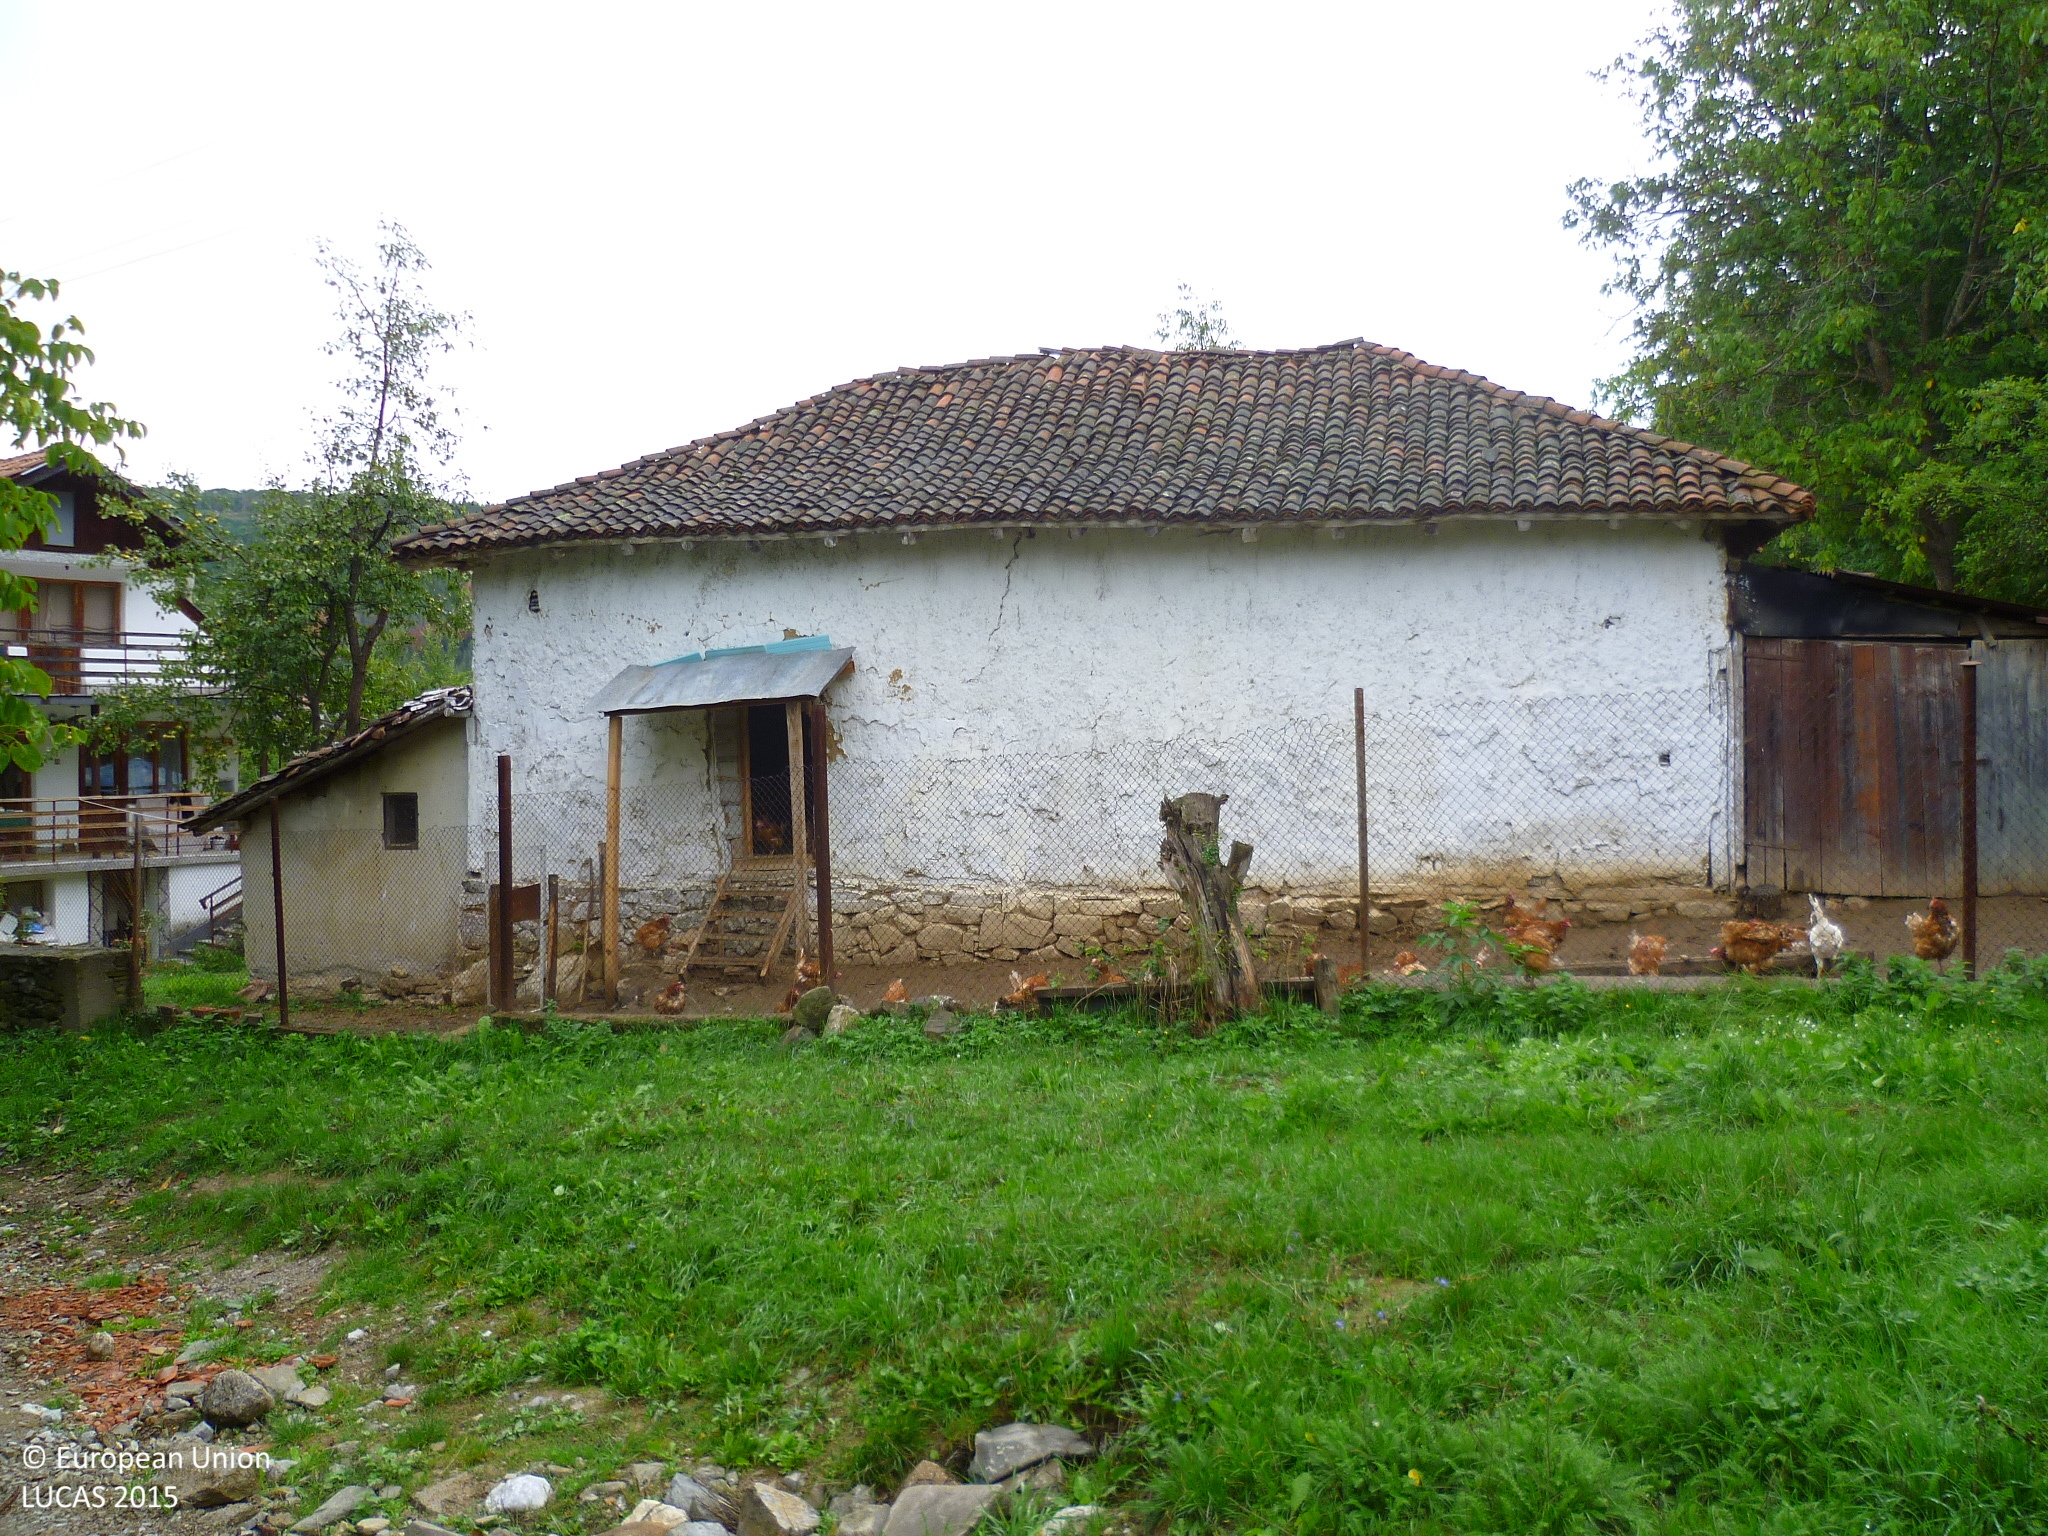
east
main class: Cropland
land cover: Nuts trees
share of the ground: 50 - 75 %
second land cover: Spontaneously vegetated surfaces
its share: 50 - 75 %
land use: Kitchen garden
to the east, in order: Nuts trees; Spontaneously vegetated surfaces; Artificial constructions in urban areas; Broadleaved woodland; Grassland with sparse tree/shrub cover
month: September
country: BG
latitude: 42.6691
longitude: 22.7276
